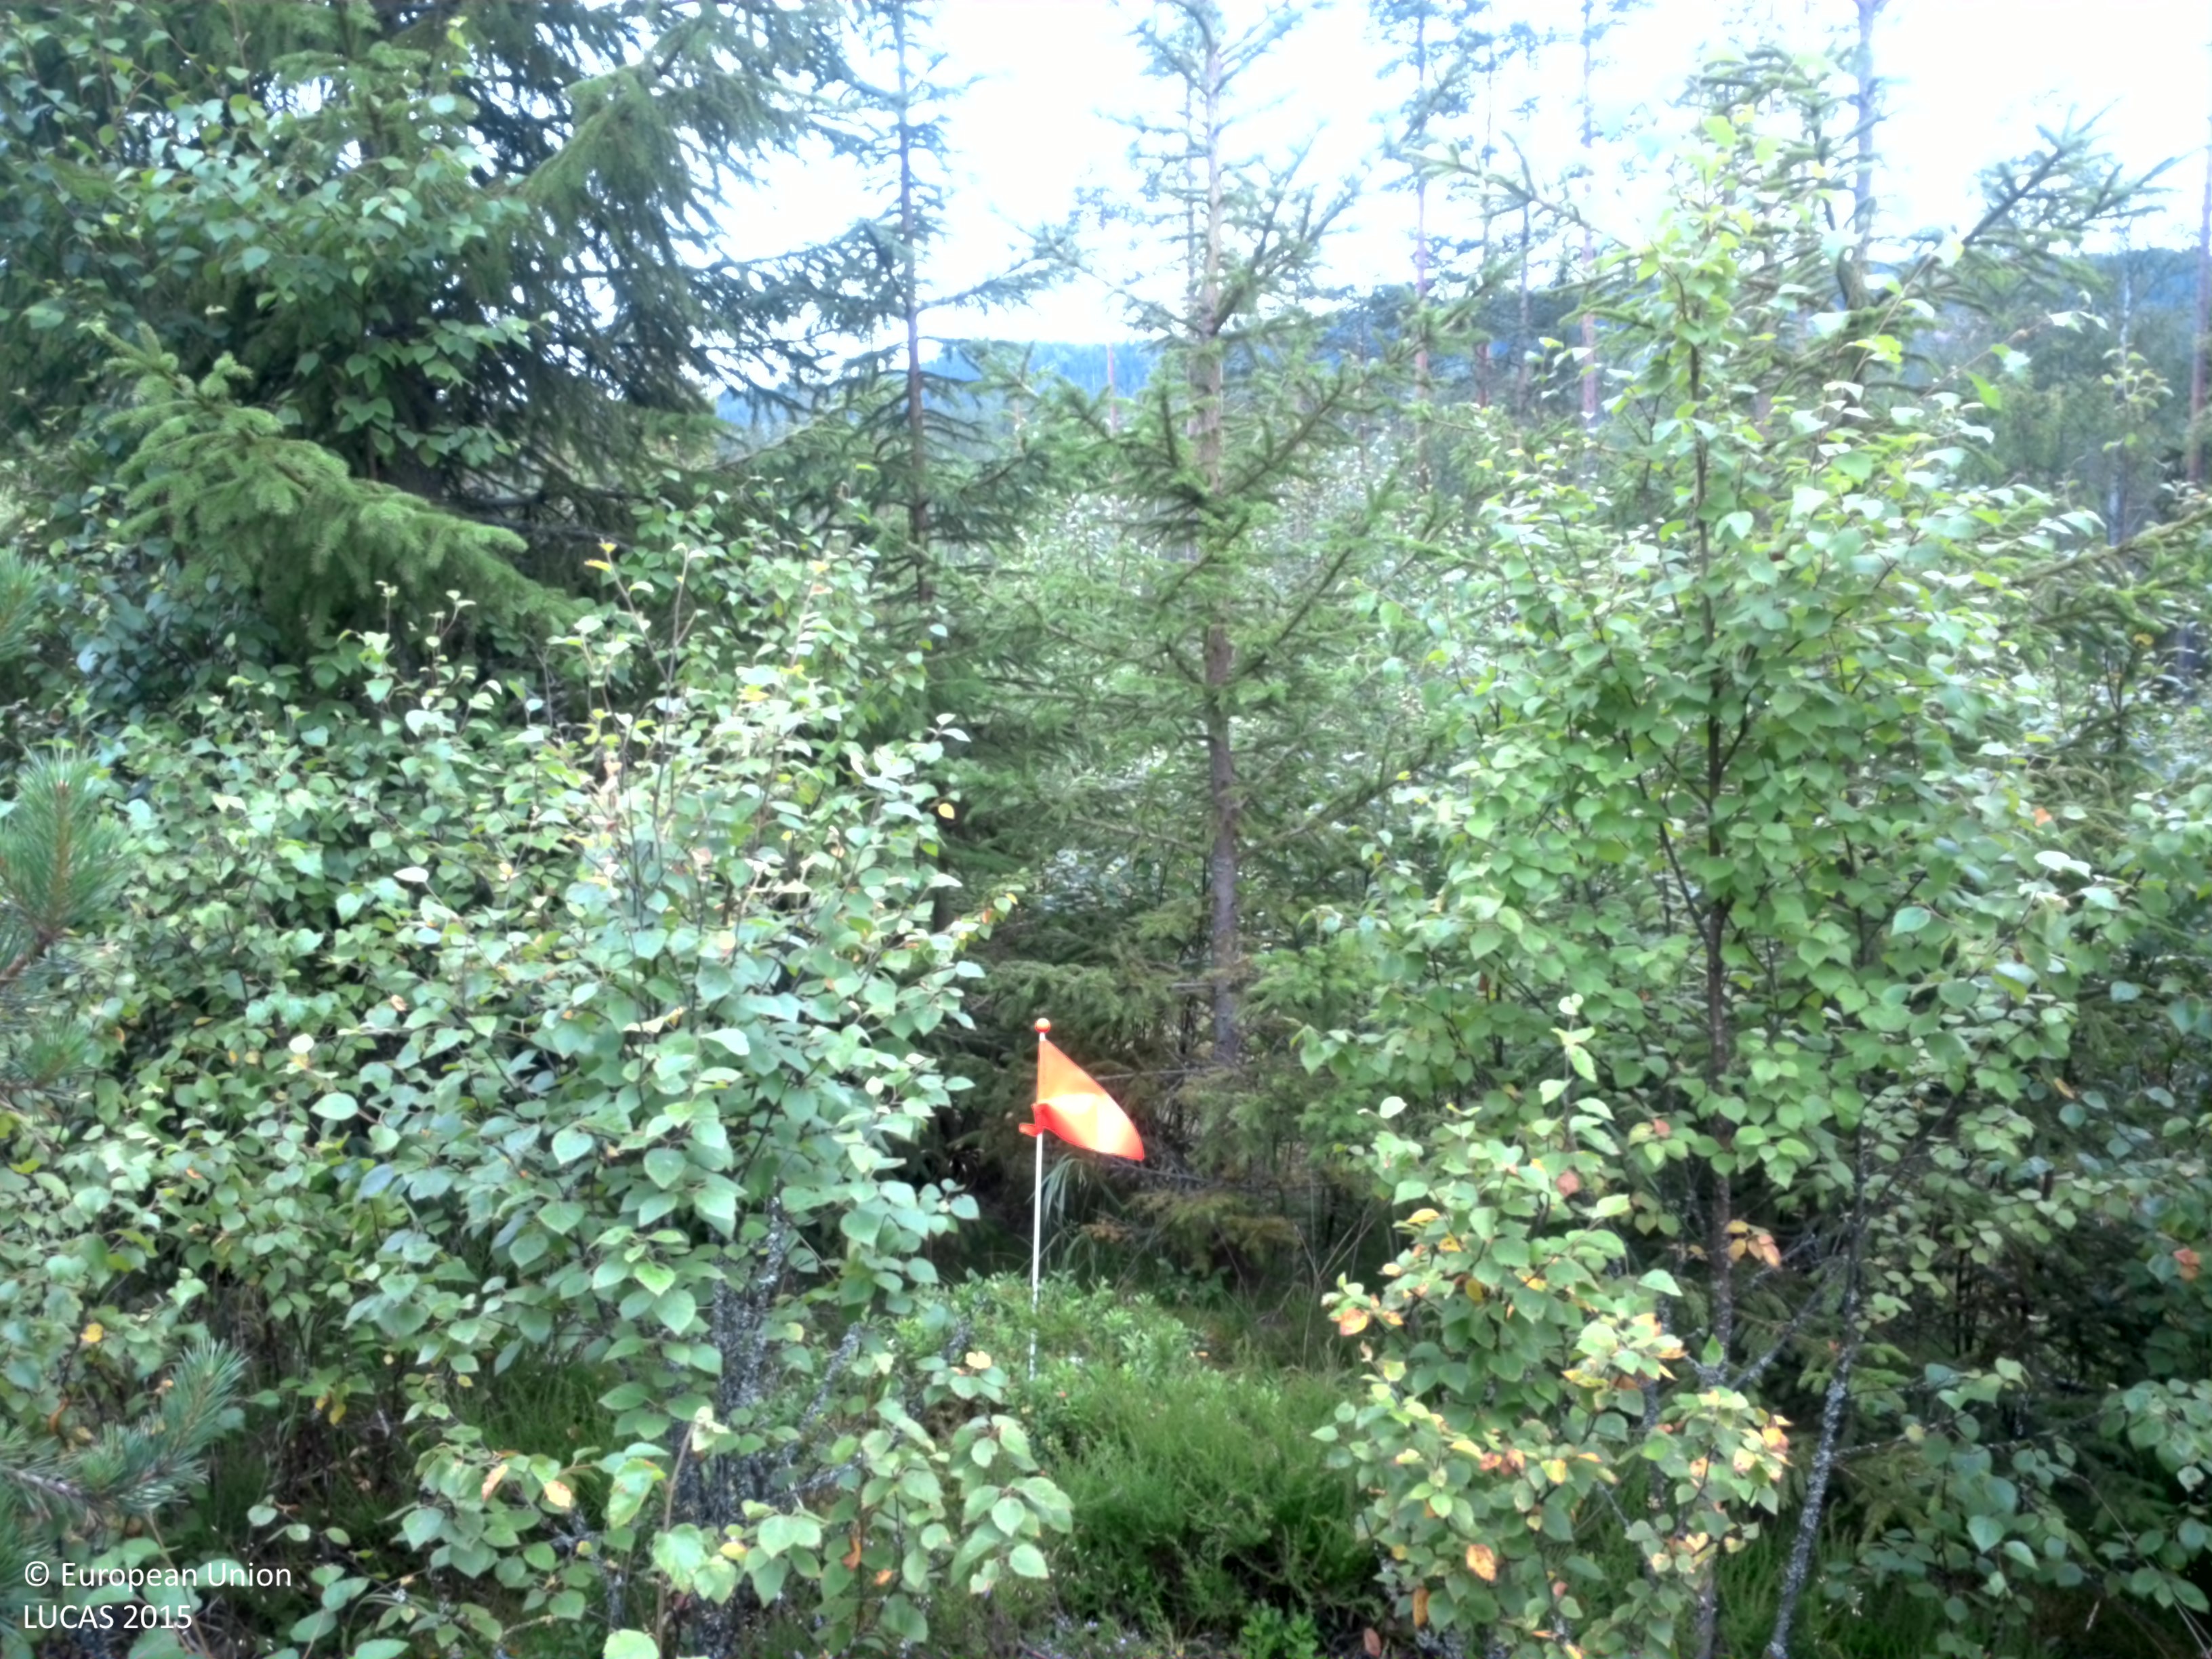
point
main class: Woodland
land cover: Spruce dominated mixed woodland
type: boreal forest
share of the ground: > 75 %
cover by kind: broadleaved forest trees 45 %, coniferous forest trees 35 %, shrubs 10 %, herbaceous plants 10 %
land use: Forestry
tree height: < 5 m
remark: Clear cut
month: August
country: SE
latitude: 60.1567
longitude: 14.1151
